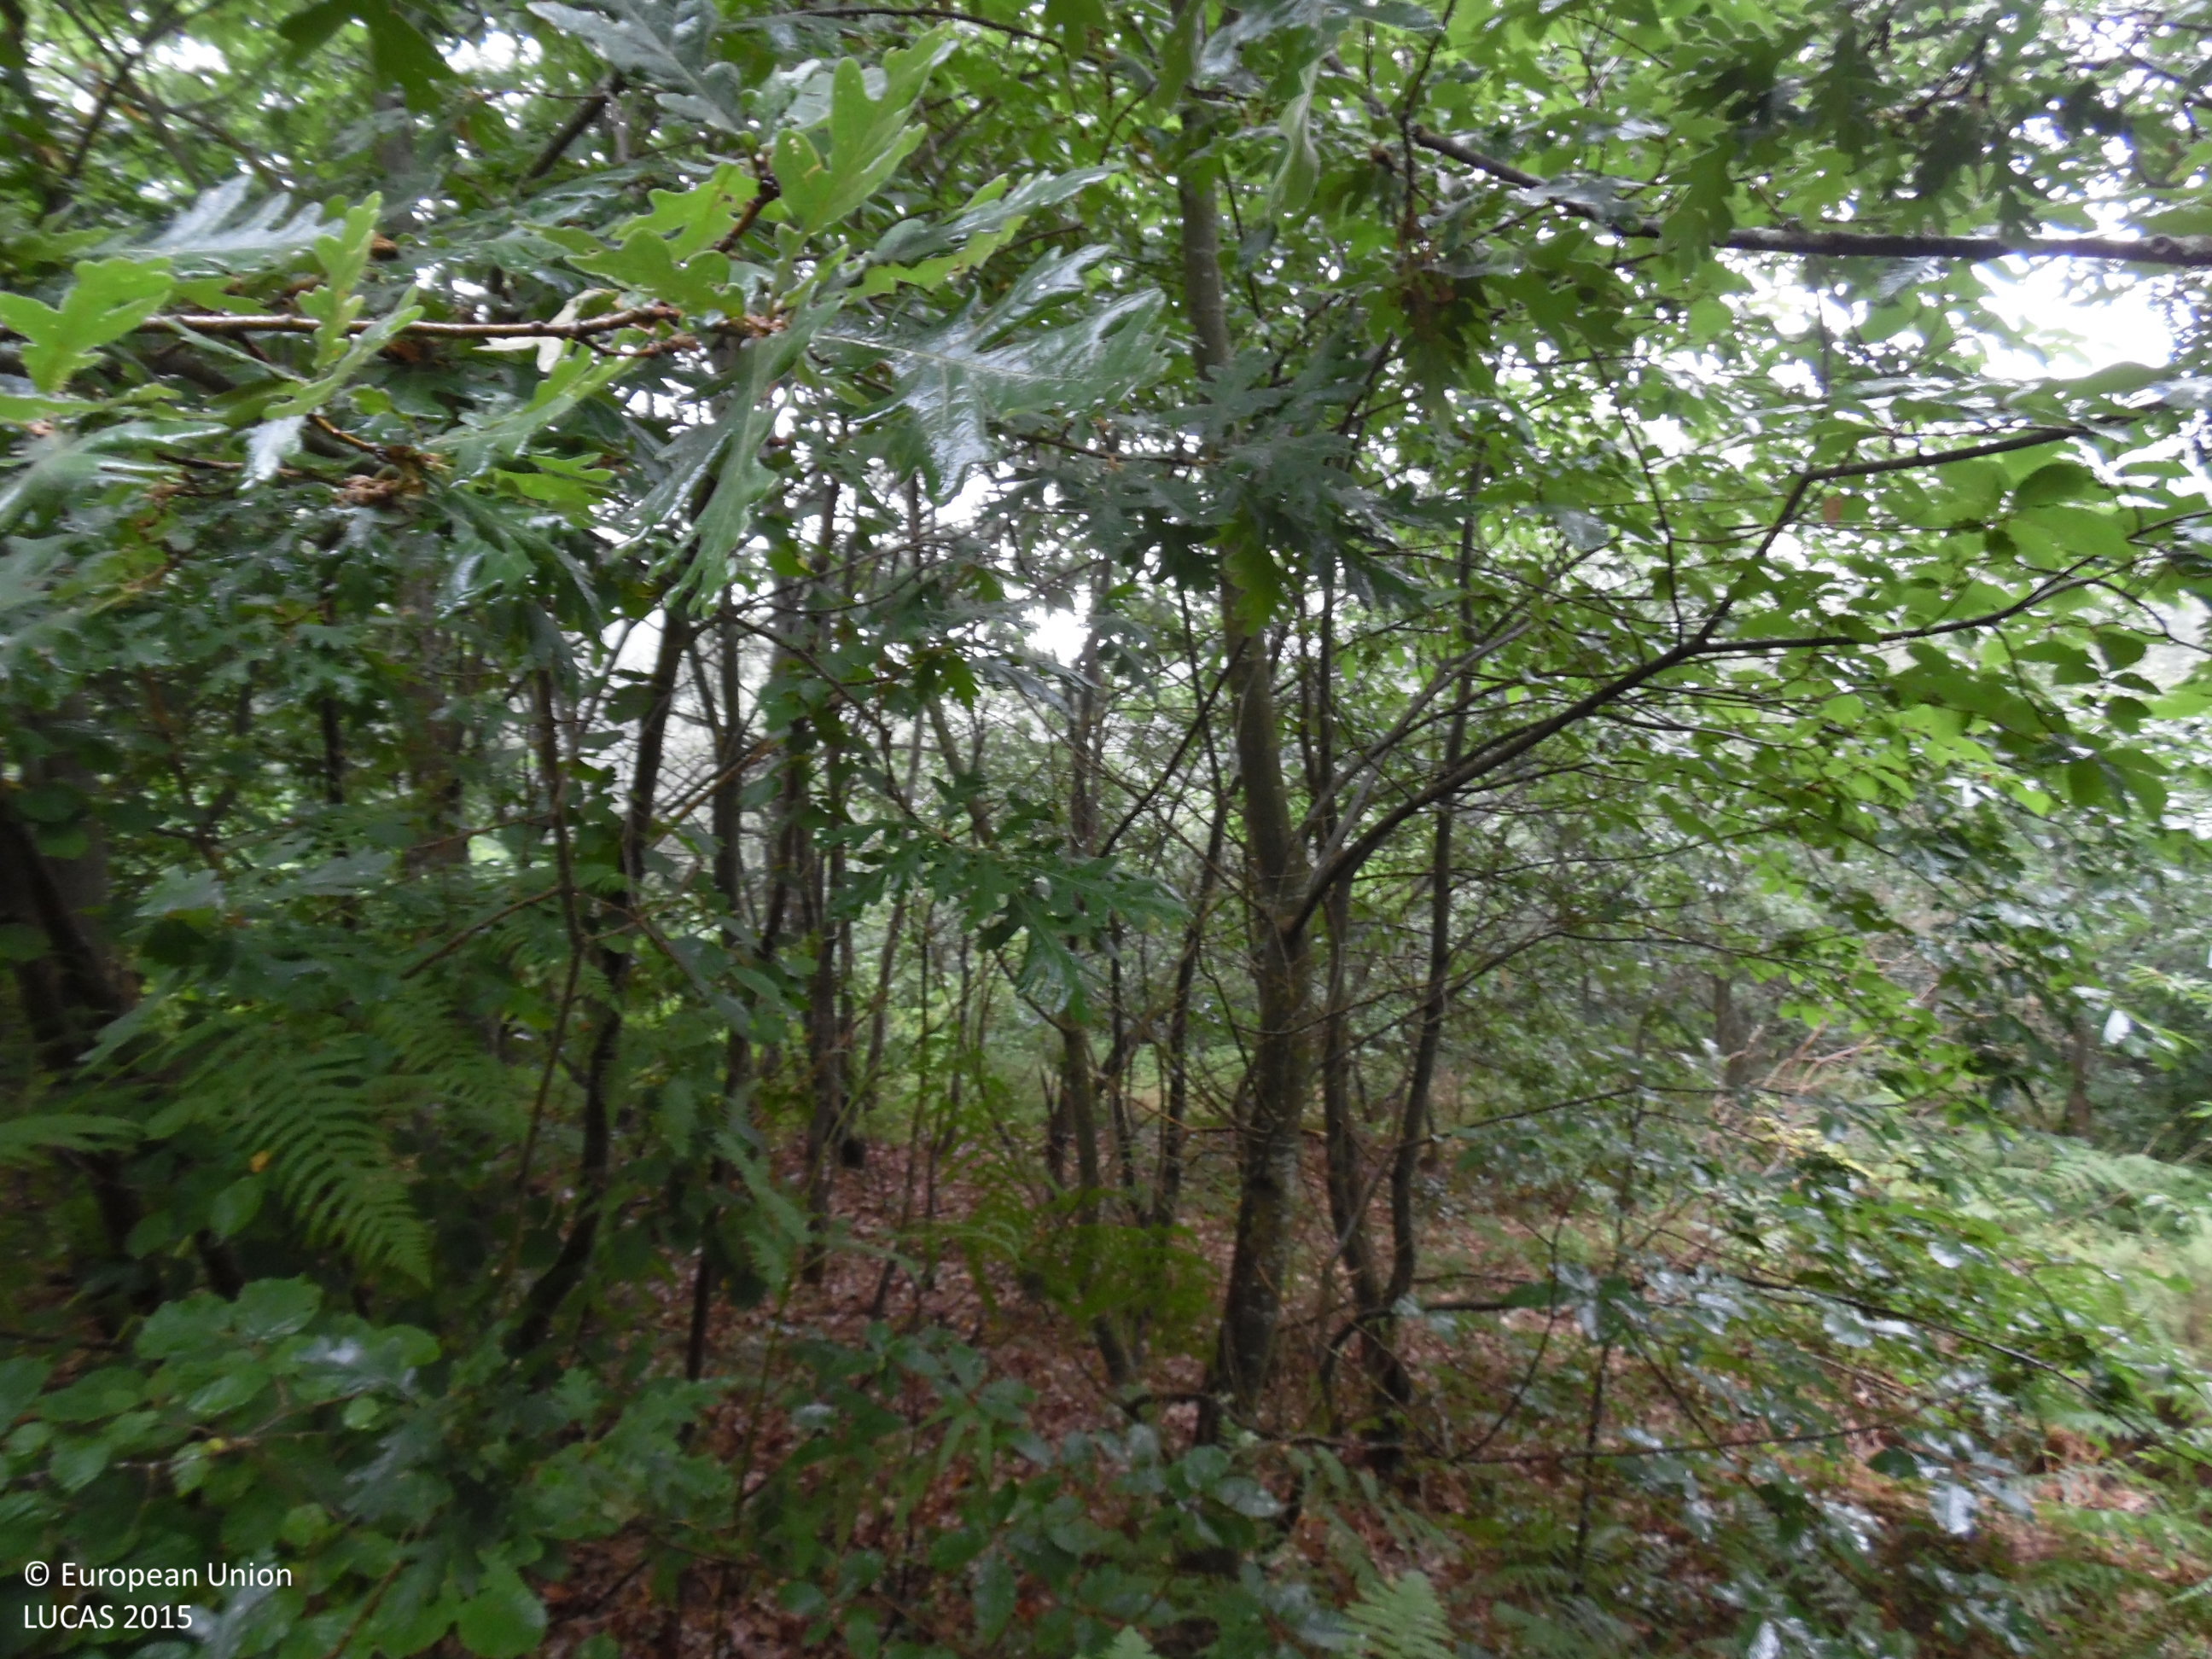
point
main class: Woodland
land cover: Broadleaved woodland
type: acidophilous oak and oak-birch forest
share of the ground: > 75 %
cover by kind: broadleaved forest trees 100 %
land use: Forestry
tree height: > 5 m
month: July
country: ES
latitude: 43.1285
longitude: -5.9317
